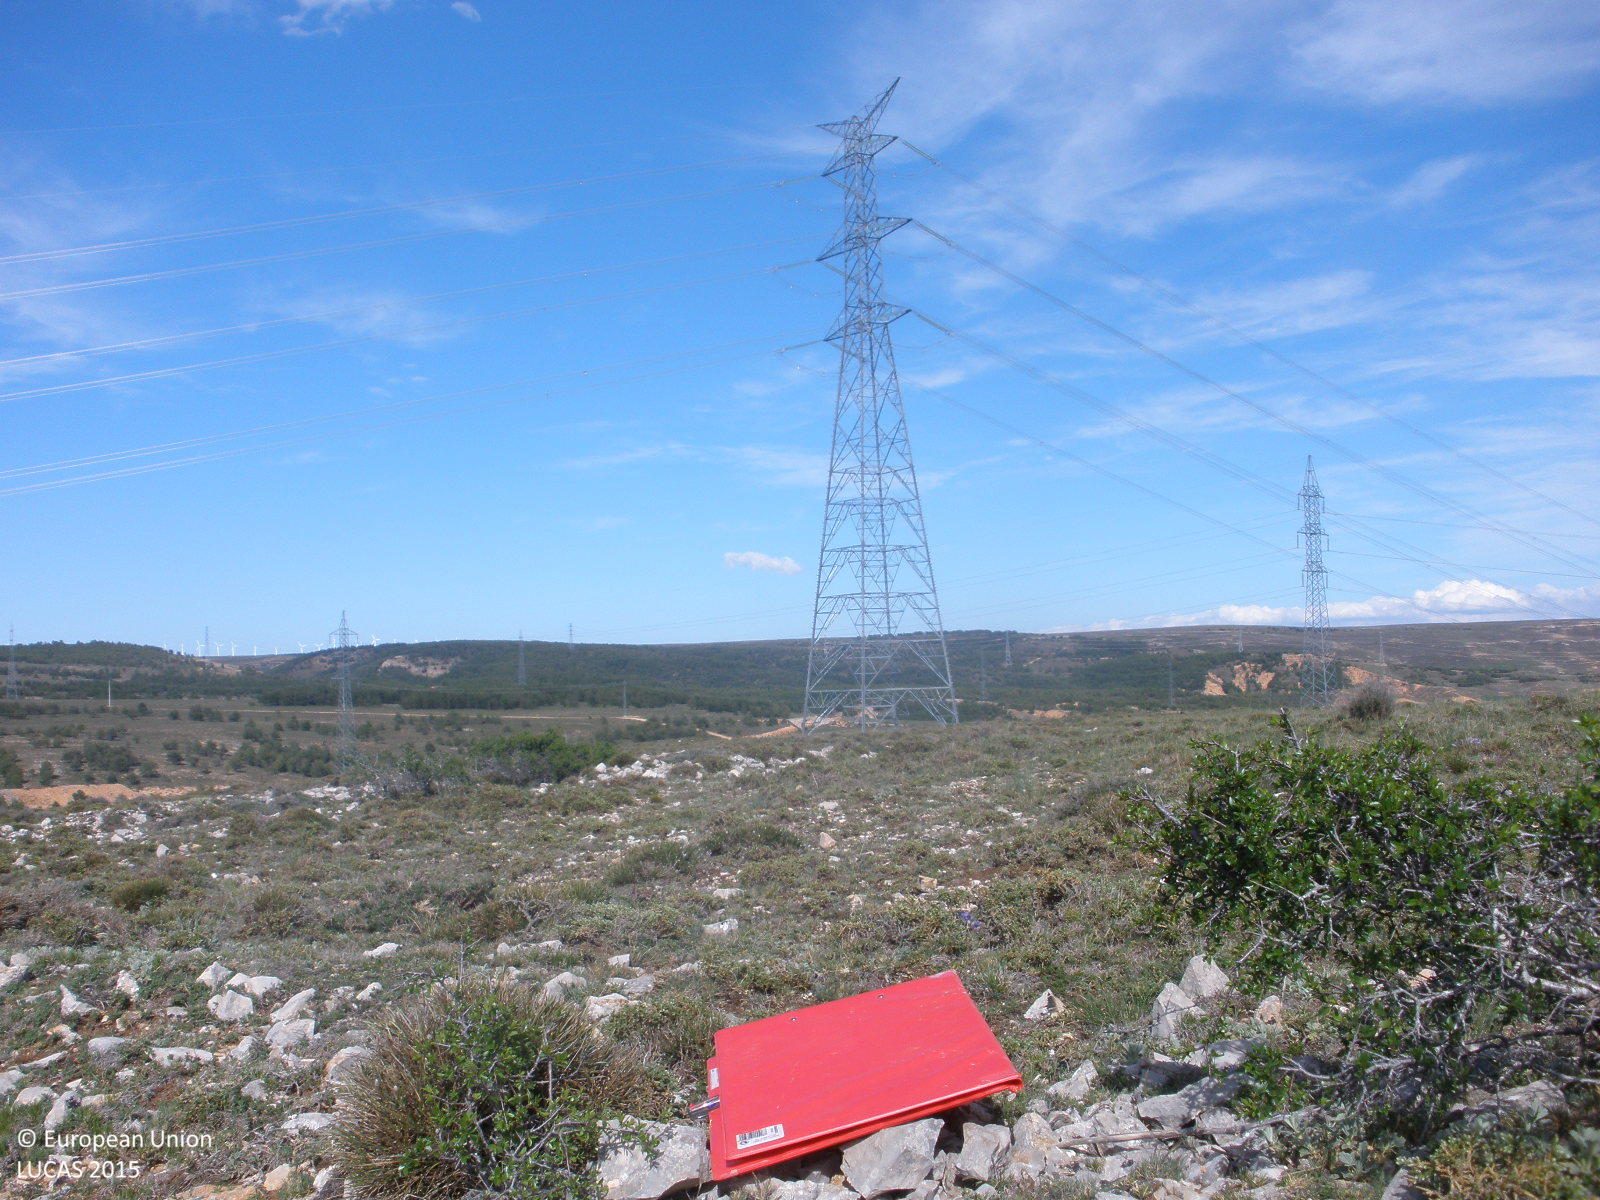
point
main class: Shrubland
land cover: Shrubland without tree cover
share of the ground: 50 - 75 %
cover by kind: shrubs 50 %, consolidated bare surface 30 %, herbaceous plants 20 %
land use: Semi-natural and natural areas not in use
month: May
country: ES
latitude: 40.7372
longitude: -0.8717
